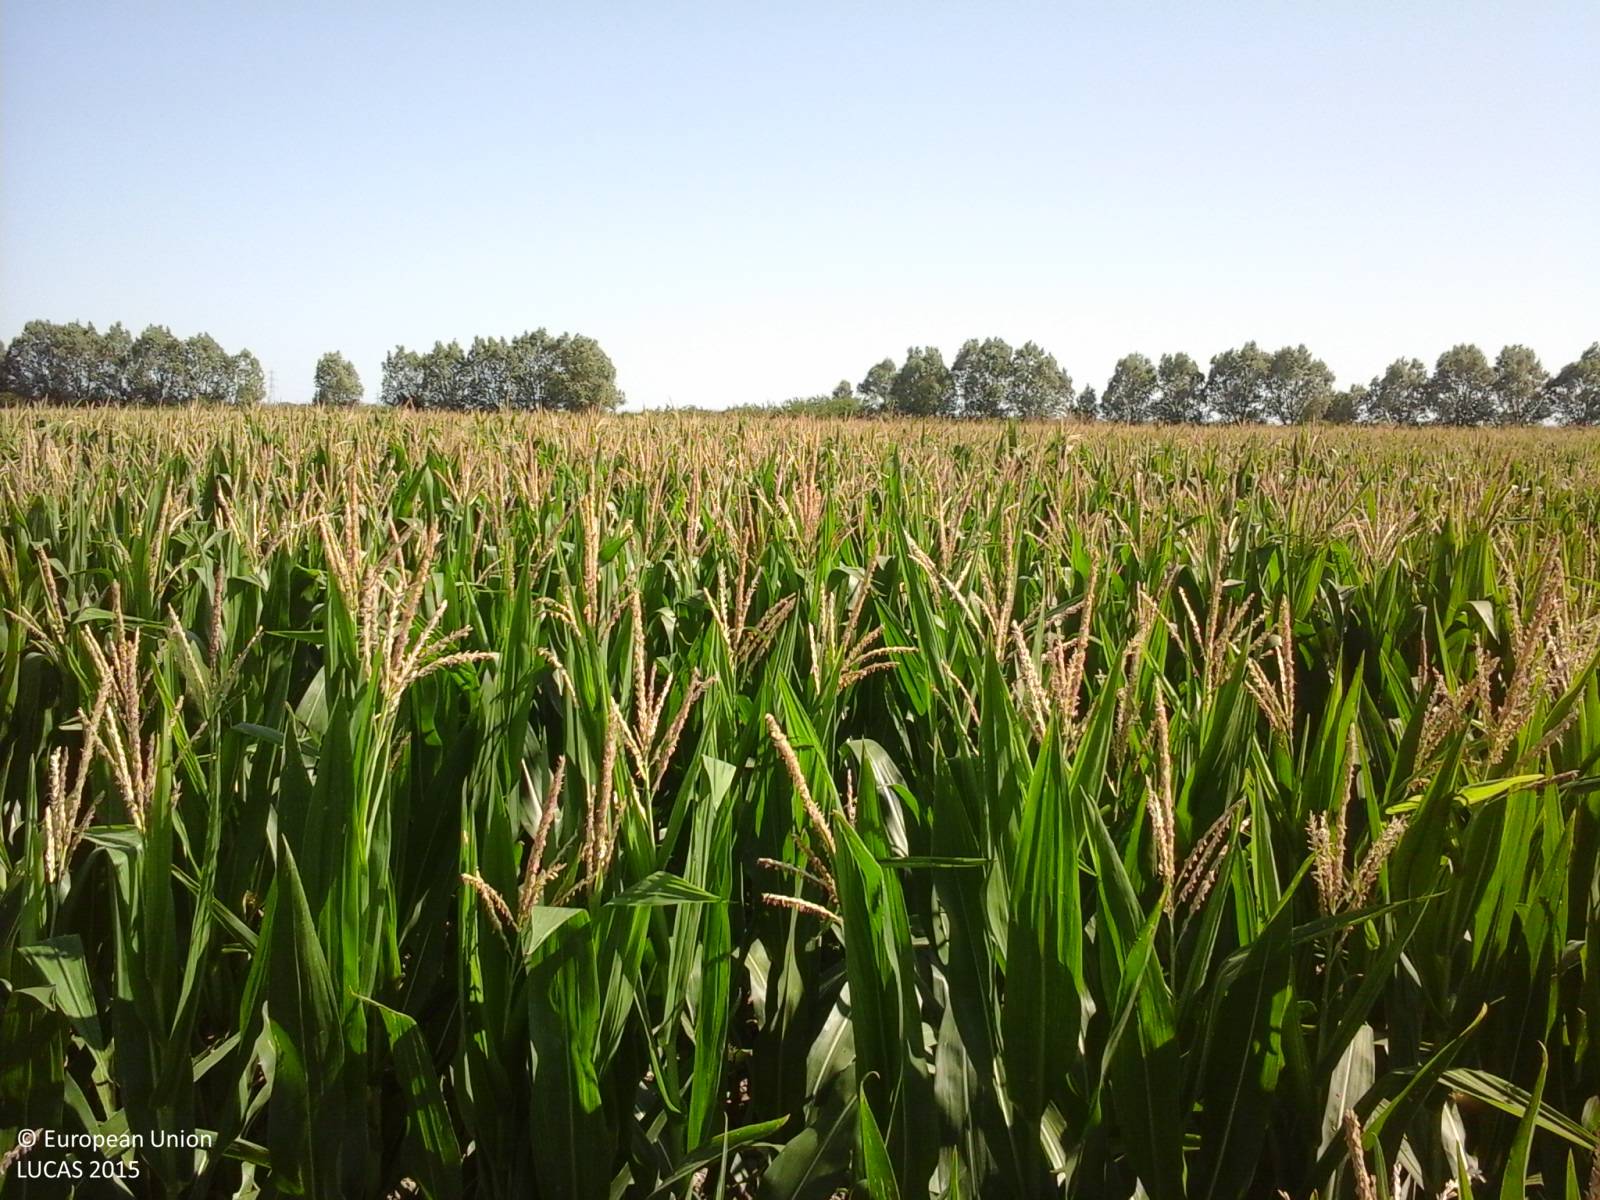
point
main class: Cropland
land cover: Maize
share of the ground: > 75 %
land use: Agriculture (excluding fallow land and kitchen gardens)
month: July
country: IT
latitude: 45.6598
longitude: 13.0120
